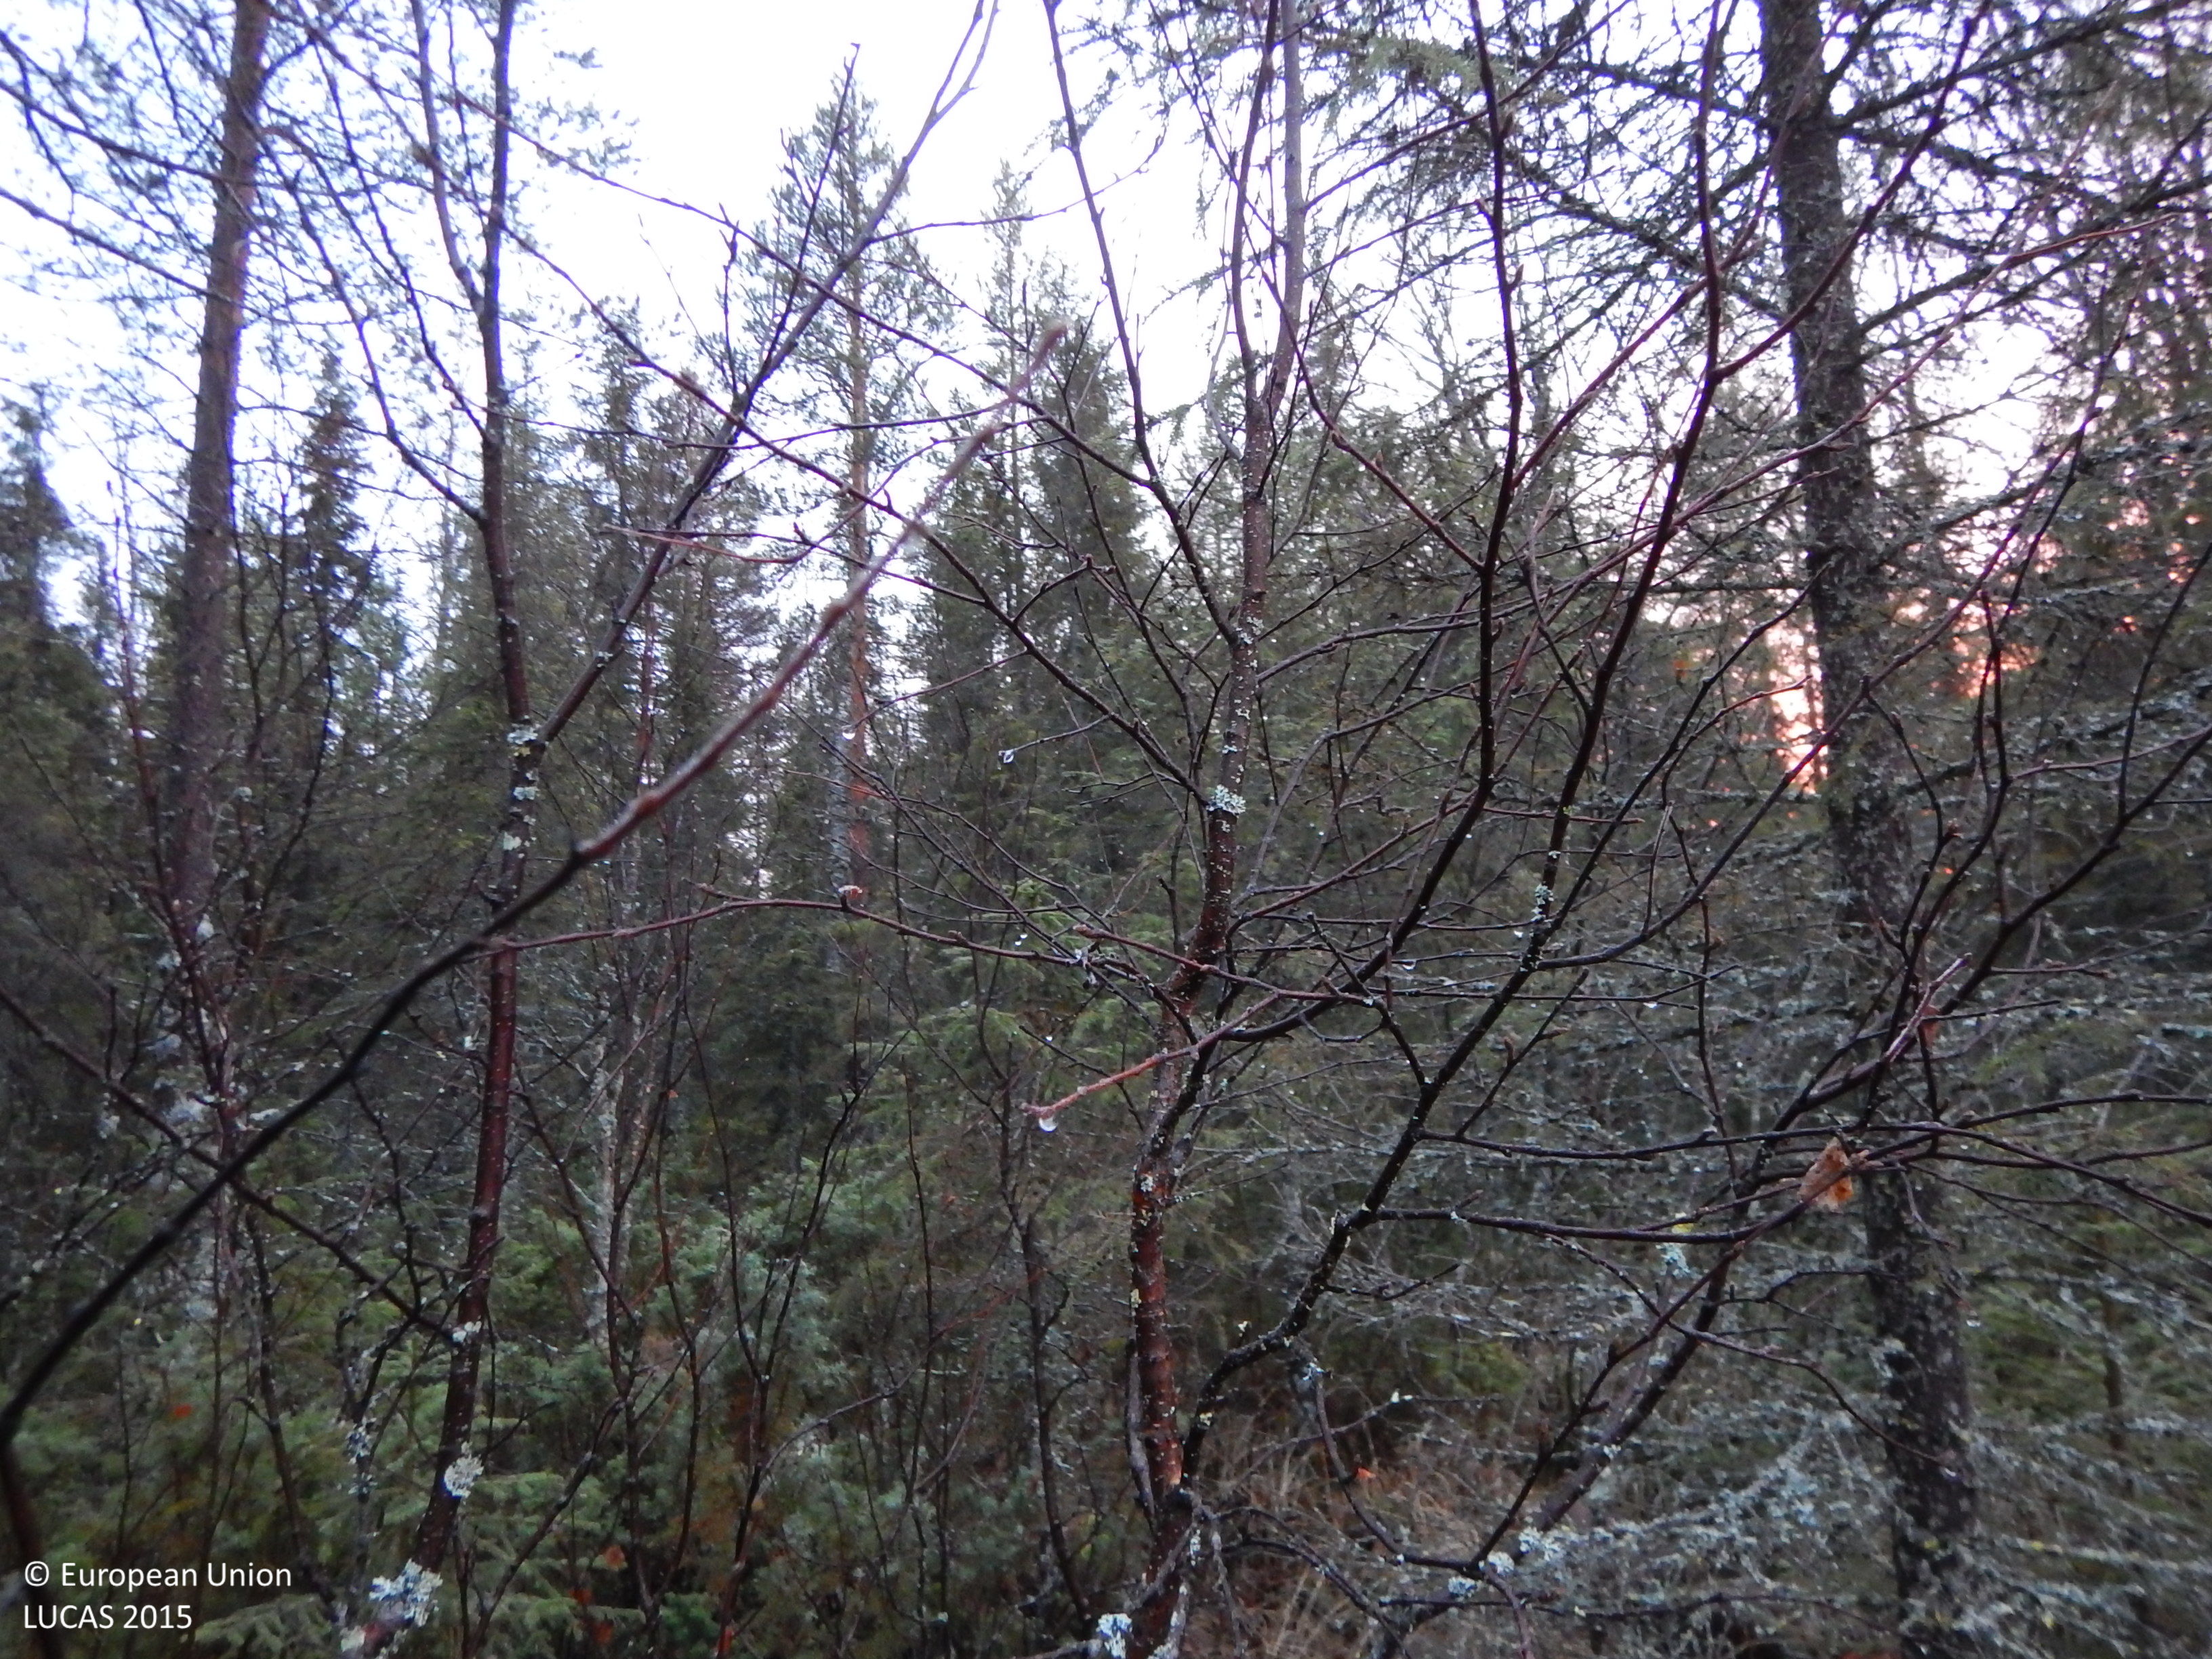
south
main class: Woodland
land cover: Broadleaved woodland
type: mire and swamp forests
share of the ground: 25 - 50 %
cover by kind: broadleaved forest trees 35 %, shrubs 20 %, herbaceous plants 20 %, lichens and mosses 20 %, coniferous forest trees 5 %
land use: Forestry
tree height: > 5 m
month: November
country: SE
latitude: 65.1457
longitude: 20.4828
